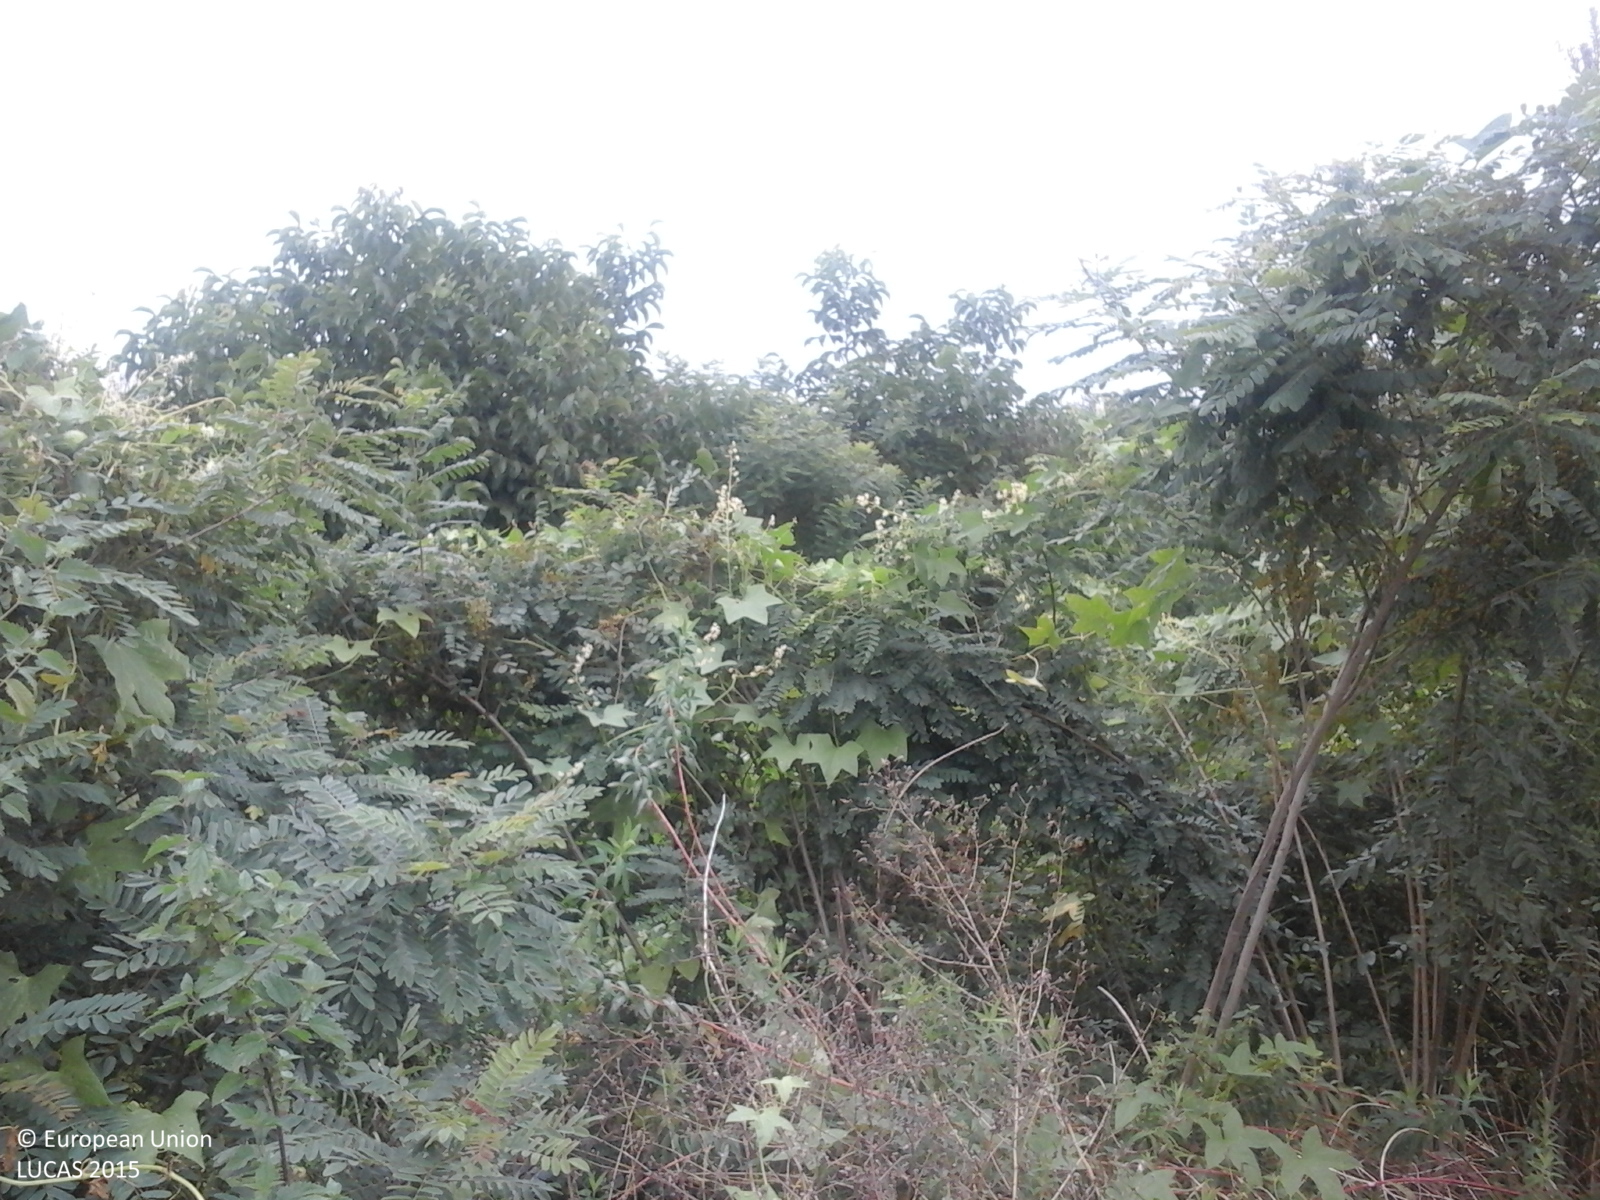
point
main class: Shrubland
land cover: Shrubland with sparse tree cover
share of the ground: > 75 %
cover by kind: shrubs 75 %, herbaceous plants 20 %, broadleaved forest trees 5 %
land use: Semi-natural and natural areas not in use
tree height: < 5 m
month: September
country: RO
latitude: 47.3233
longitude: 22.0499
